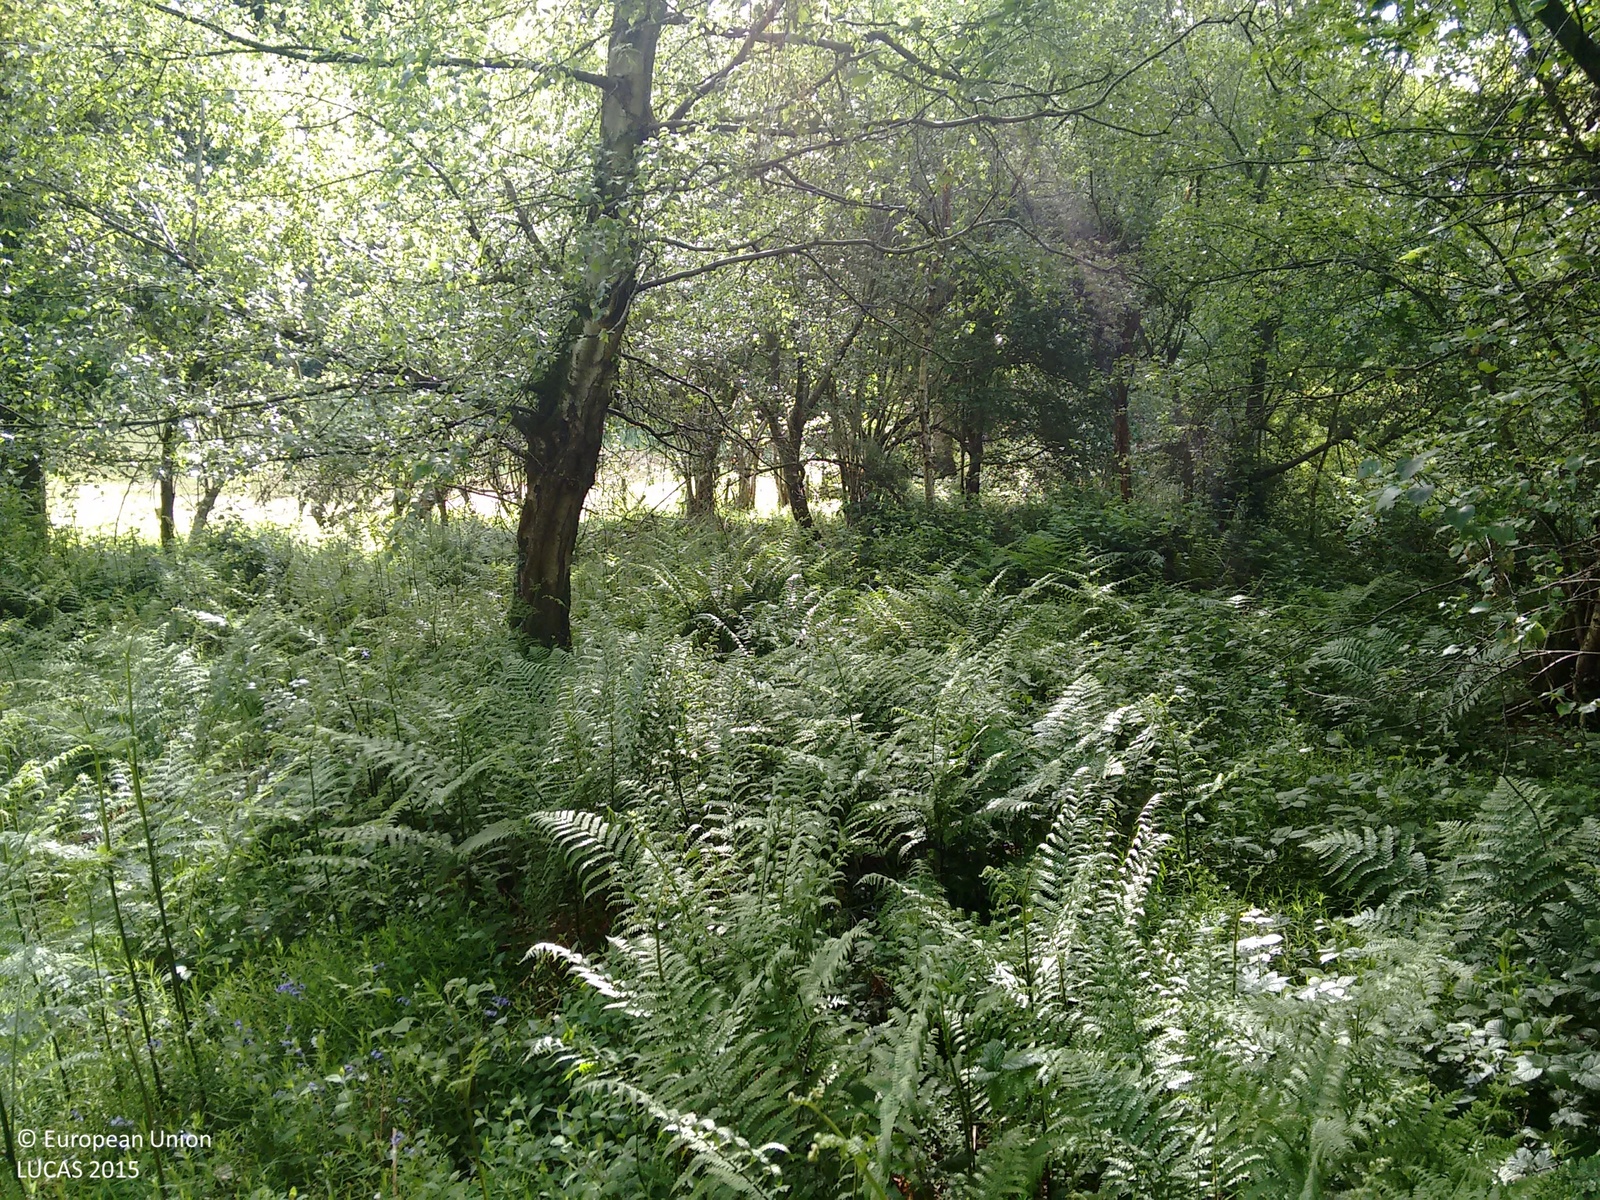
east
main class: Woodland
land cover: Broadleaved woodland
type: mesophytic deciduous forest
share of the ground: > 75 %
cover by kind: broadleaved forest trees 90 %, herbaceous plants 10 %
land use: Semi-natural and natural areas not in use
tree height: > 5 m
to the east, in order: Broadleaved woodland; Fences; Grassland without tree/shrub cover; Fences; Shruby margins; Paved roads, cycling and walking lanes; Broadleaved woodland; Spruce dominated coniferous woodland; Broadleaved woodland
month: June
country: GB
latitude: 51.0245
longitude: -2.1363
